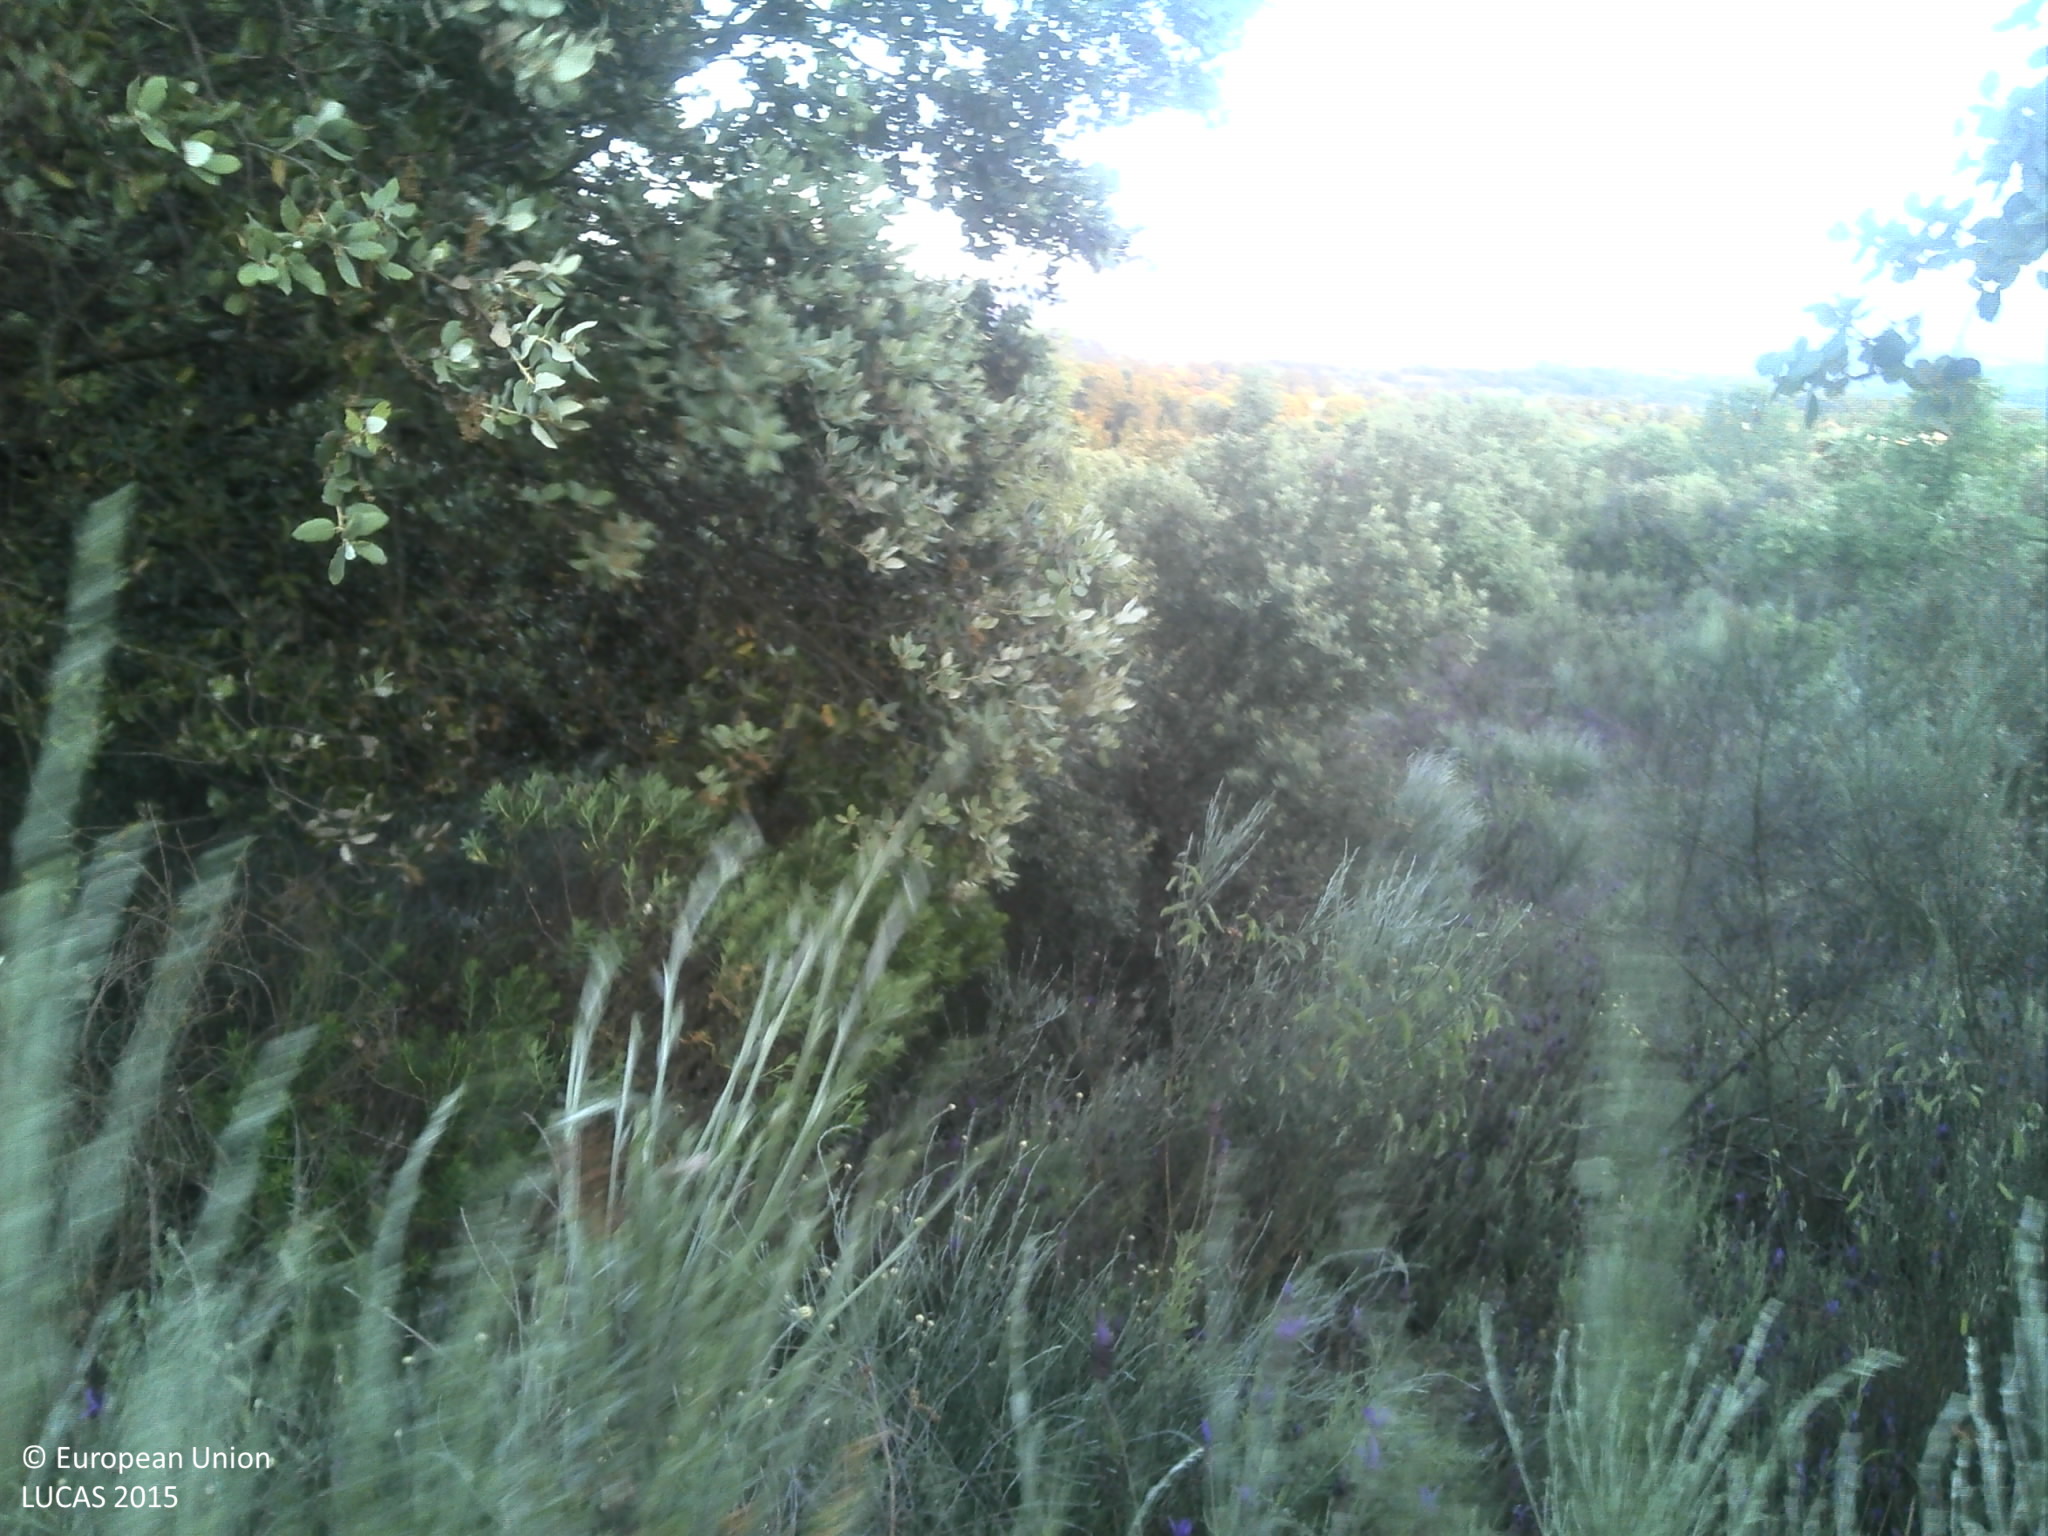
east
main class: Shrubland
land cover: Shrubland with sparse tree cover
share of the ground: > 75 %
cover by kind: shrubs 95 %, broadleaved forest trees 5 %
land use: Abandoned areas
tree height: > 5 m
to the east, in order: Shrubland with sparse tree cover; Dry stone walls; Shrubland with sparse tree cover; Tracks; Grassland without tree/shrub cover; Maize; Abandoned hedges; Maize; Olive groves; Other fruit trees and berries; Shrubland without tree cover; Dry stone walls; Ditches and canals; Dry stone walls; Tracks; Shrubland without tree cover
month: May
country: PT
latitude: 40.6648
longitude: -7.3444
